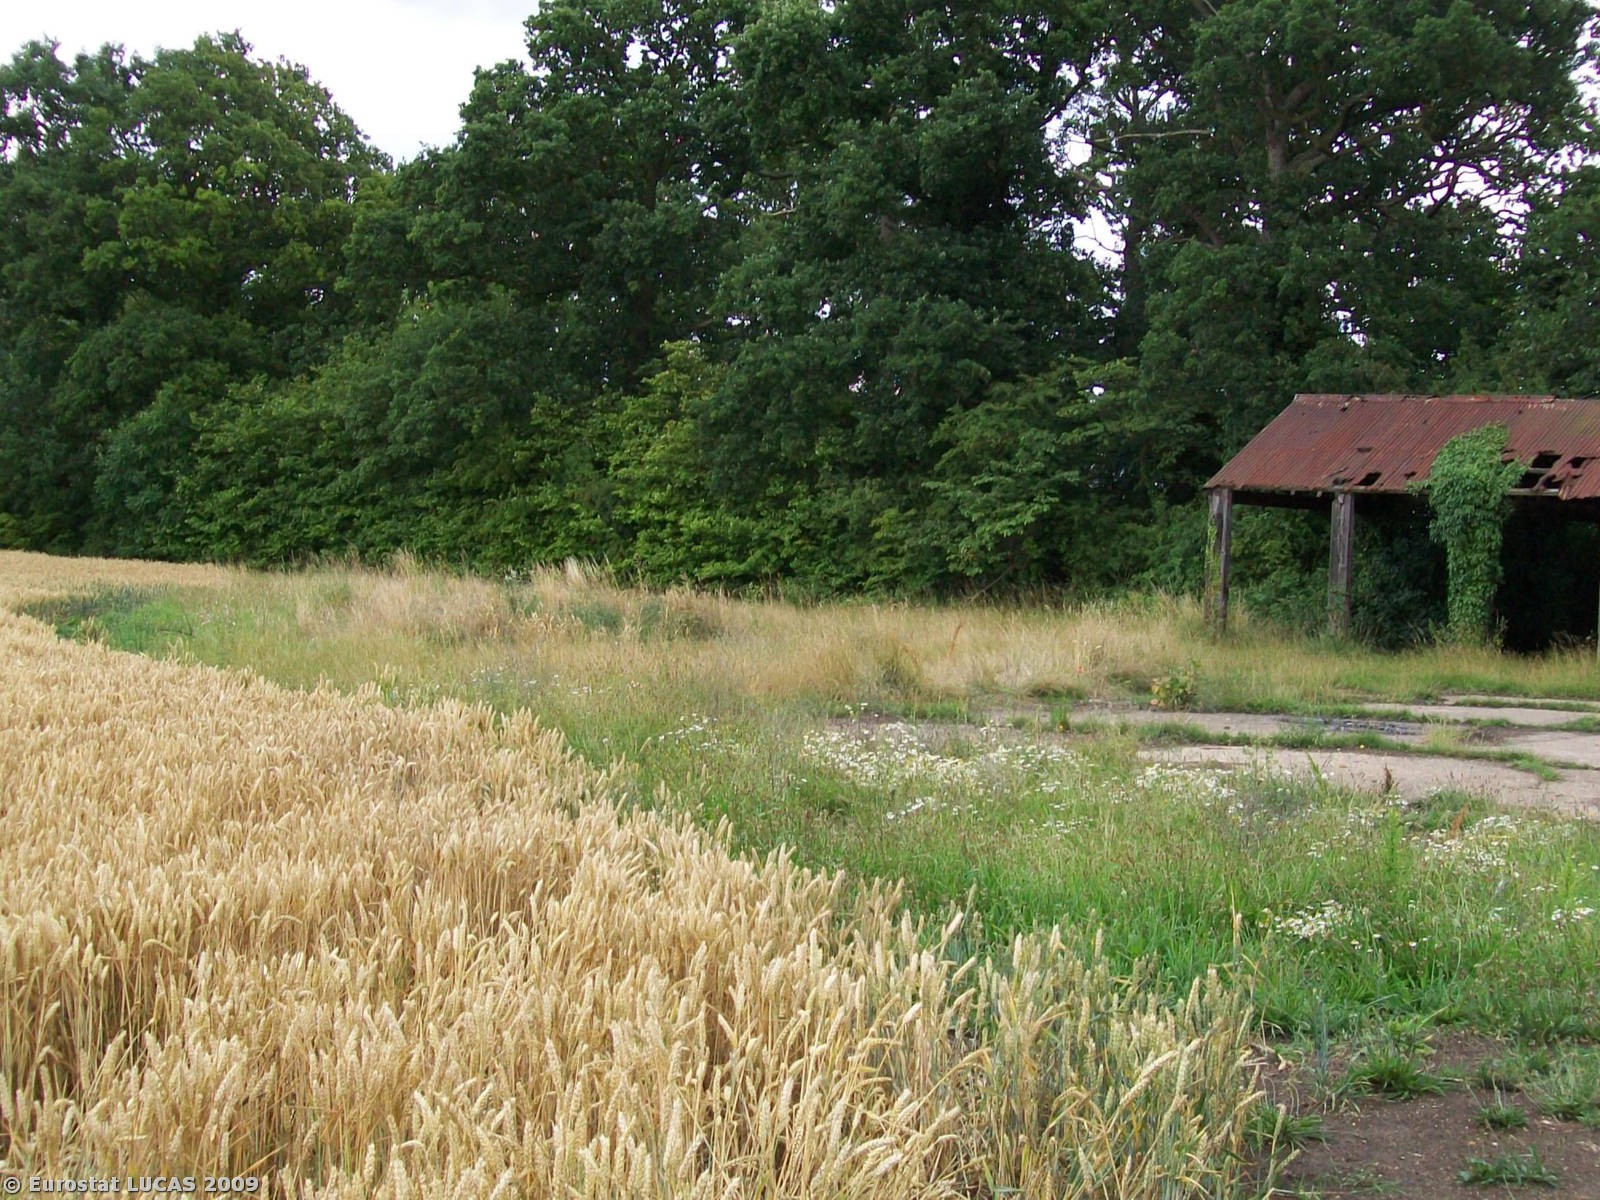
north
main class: Cropland
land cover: Common wheat
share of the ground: > 75 %
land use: Agriculture (excluding fallow land and kitchen gardens)
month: July
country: GB
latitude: 52.2460
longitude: 0.0227
